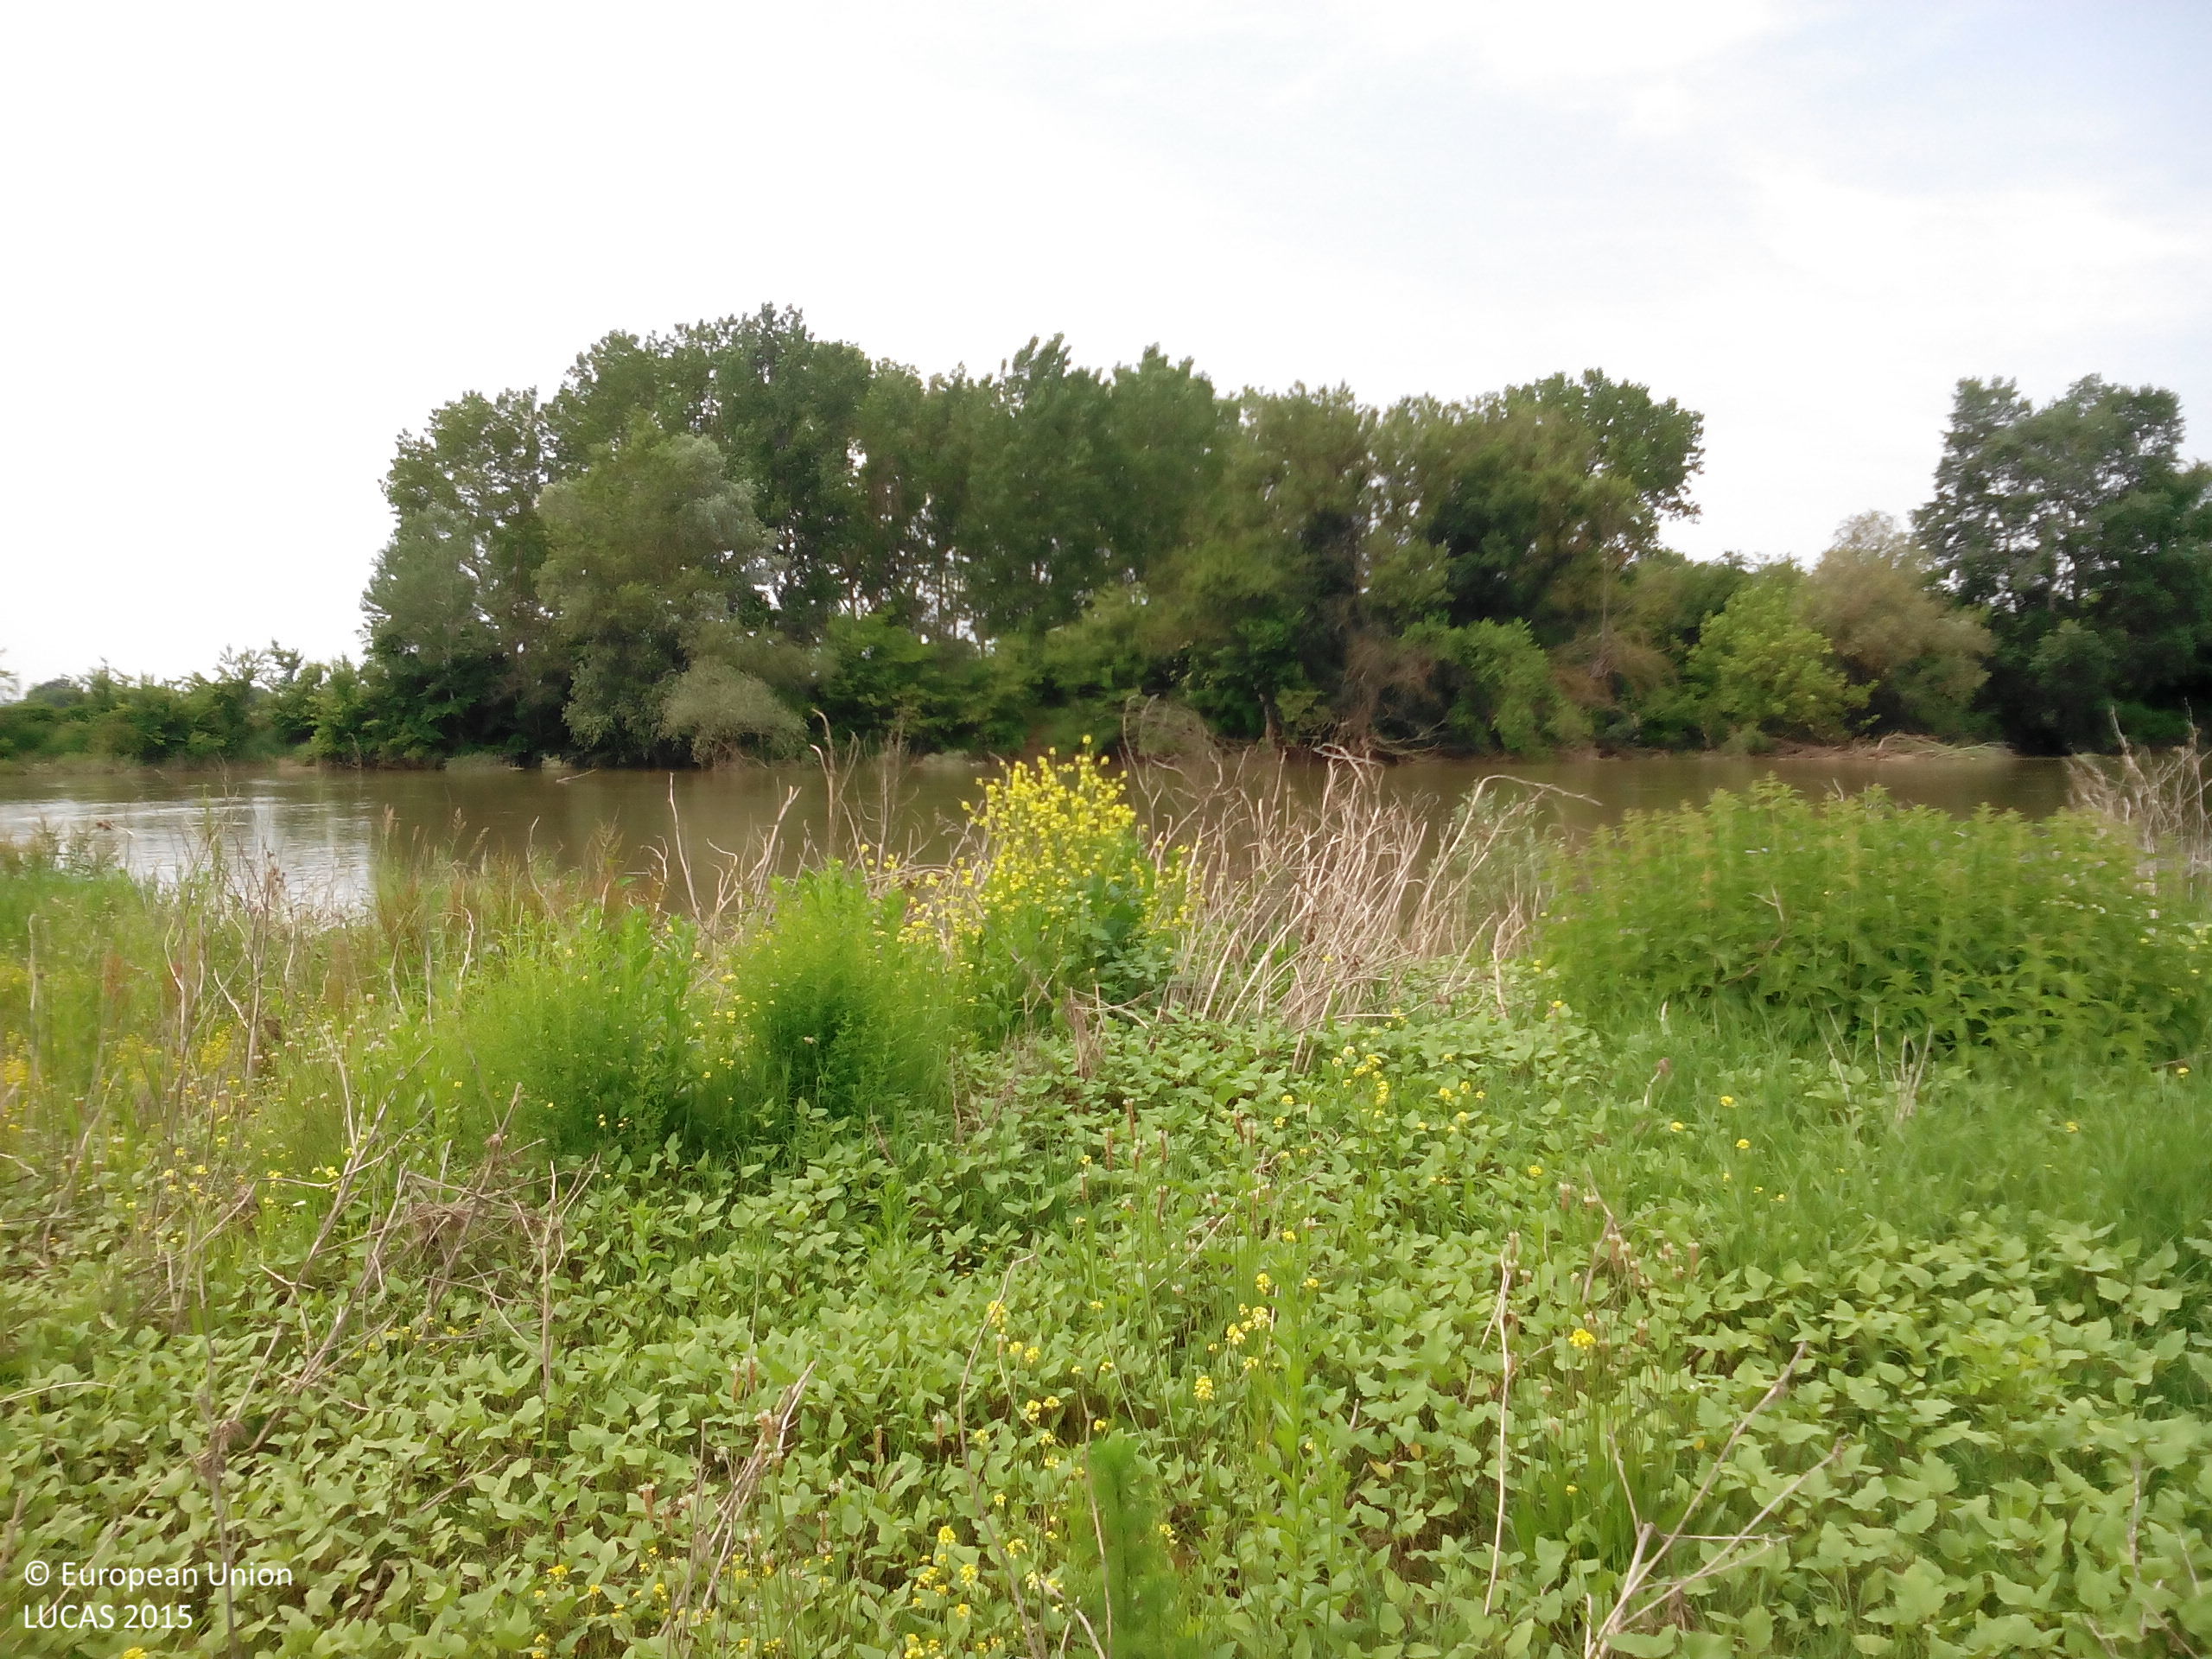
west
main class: Grassland
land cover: Grassland without tree/shrub cover
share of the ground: > 75 %
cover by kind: herbaceous plants 95 %, shrubs 5 %
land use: Agriculture (excluding fallow land and kitchen gardens)
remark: Temporary dry
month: May
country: BG
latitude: 43.4907
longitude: 24.2402
